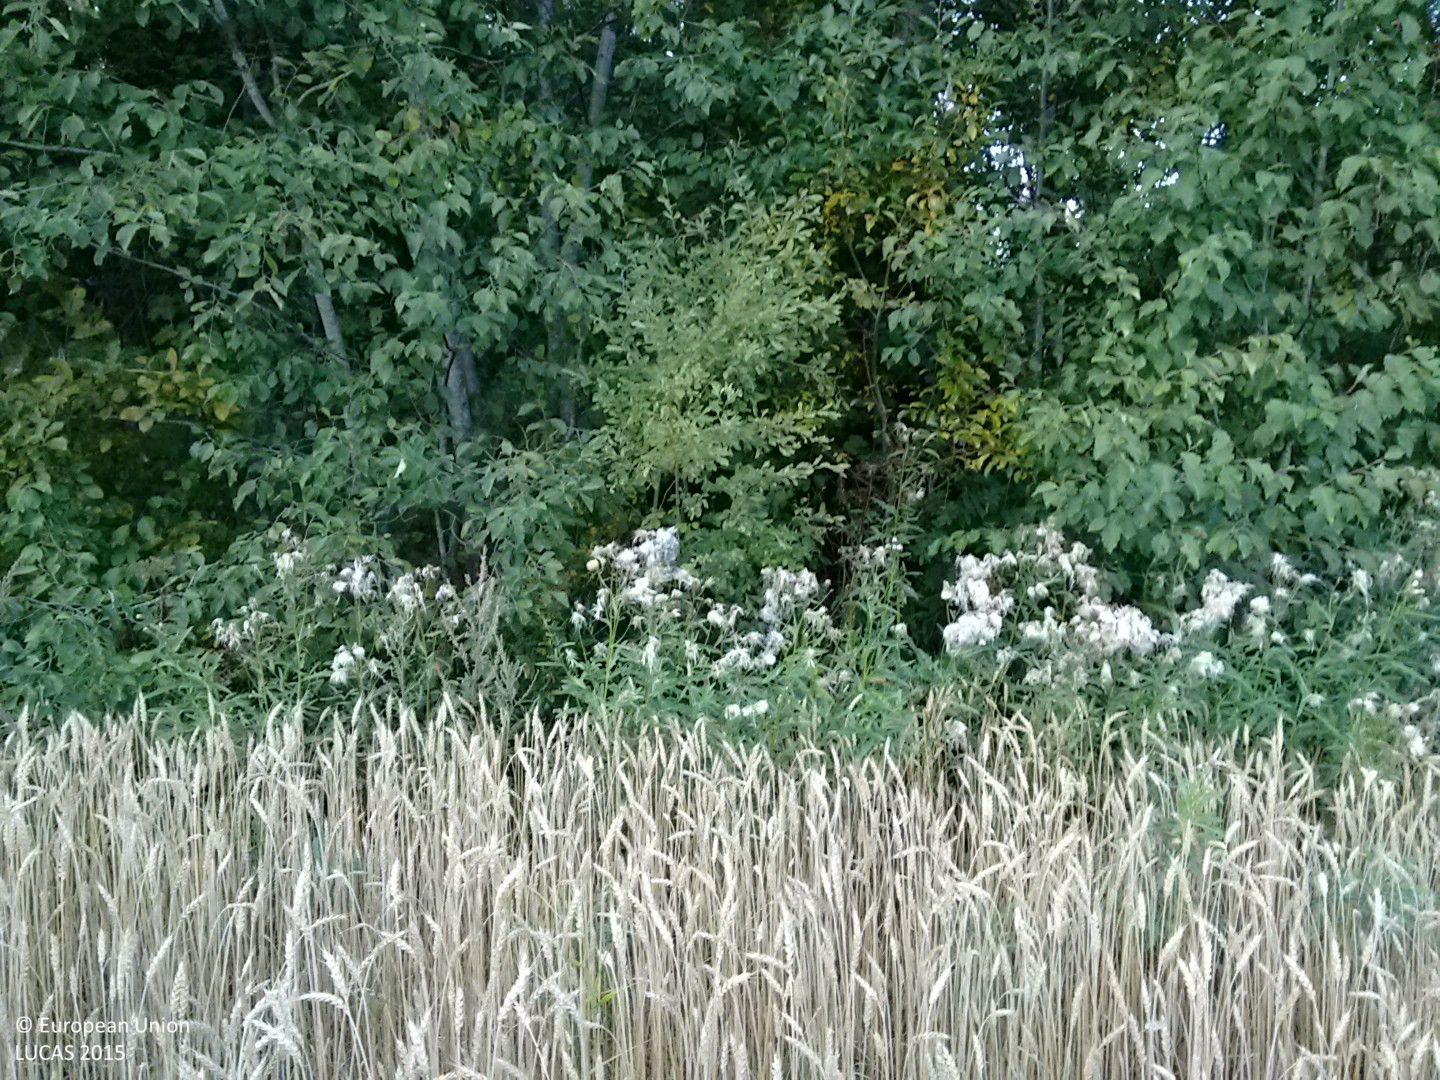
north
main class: Cropland
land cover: Common wheat
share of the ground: > 75 %
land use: Agriculture (excluding fallow land and kitchen gardens)
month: September
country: FI
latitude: 60.8754
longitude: 21.9401
